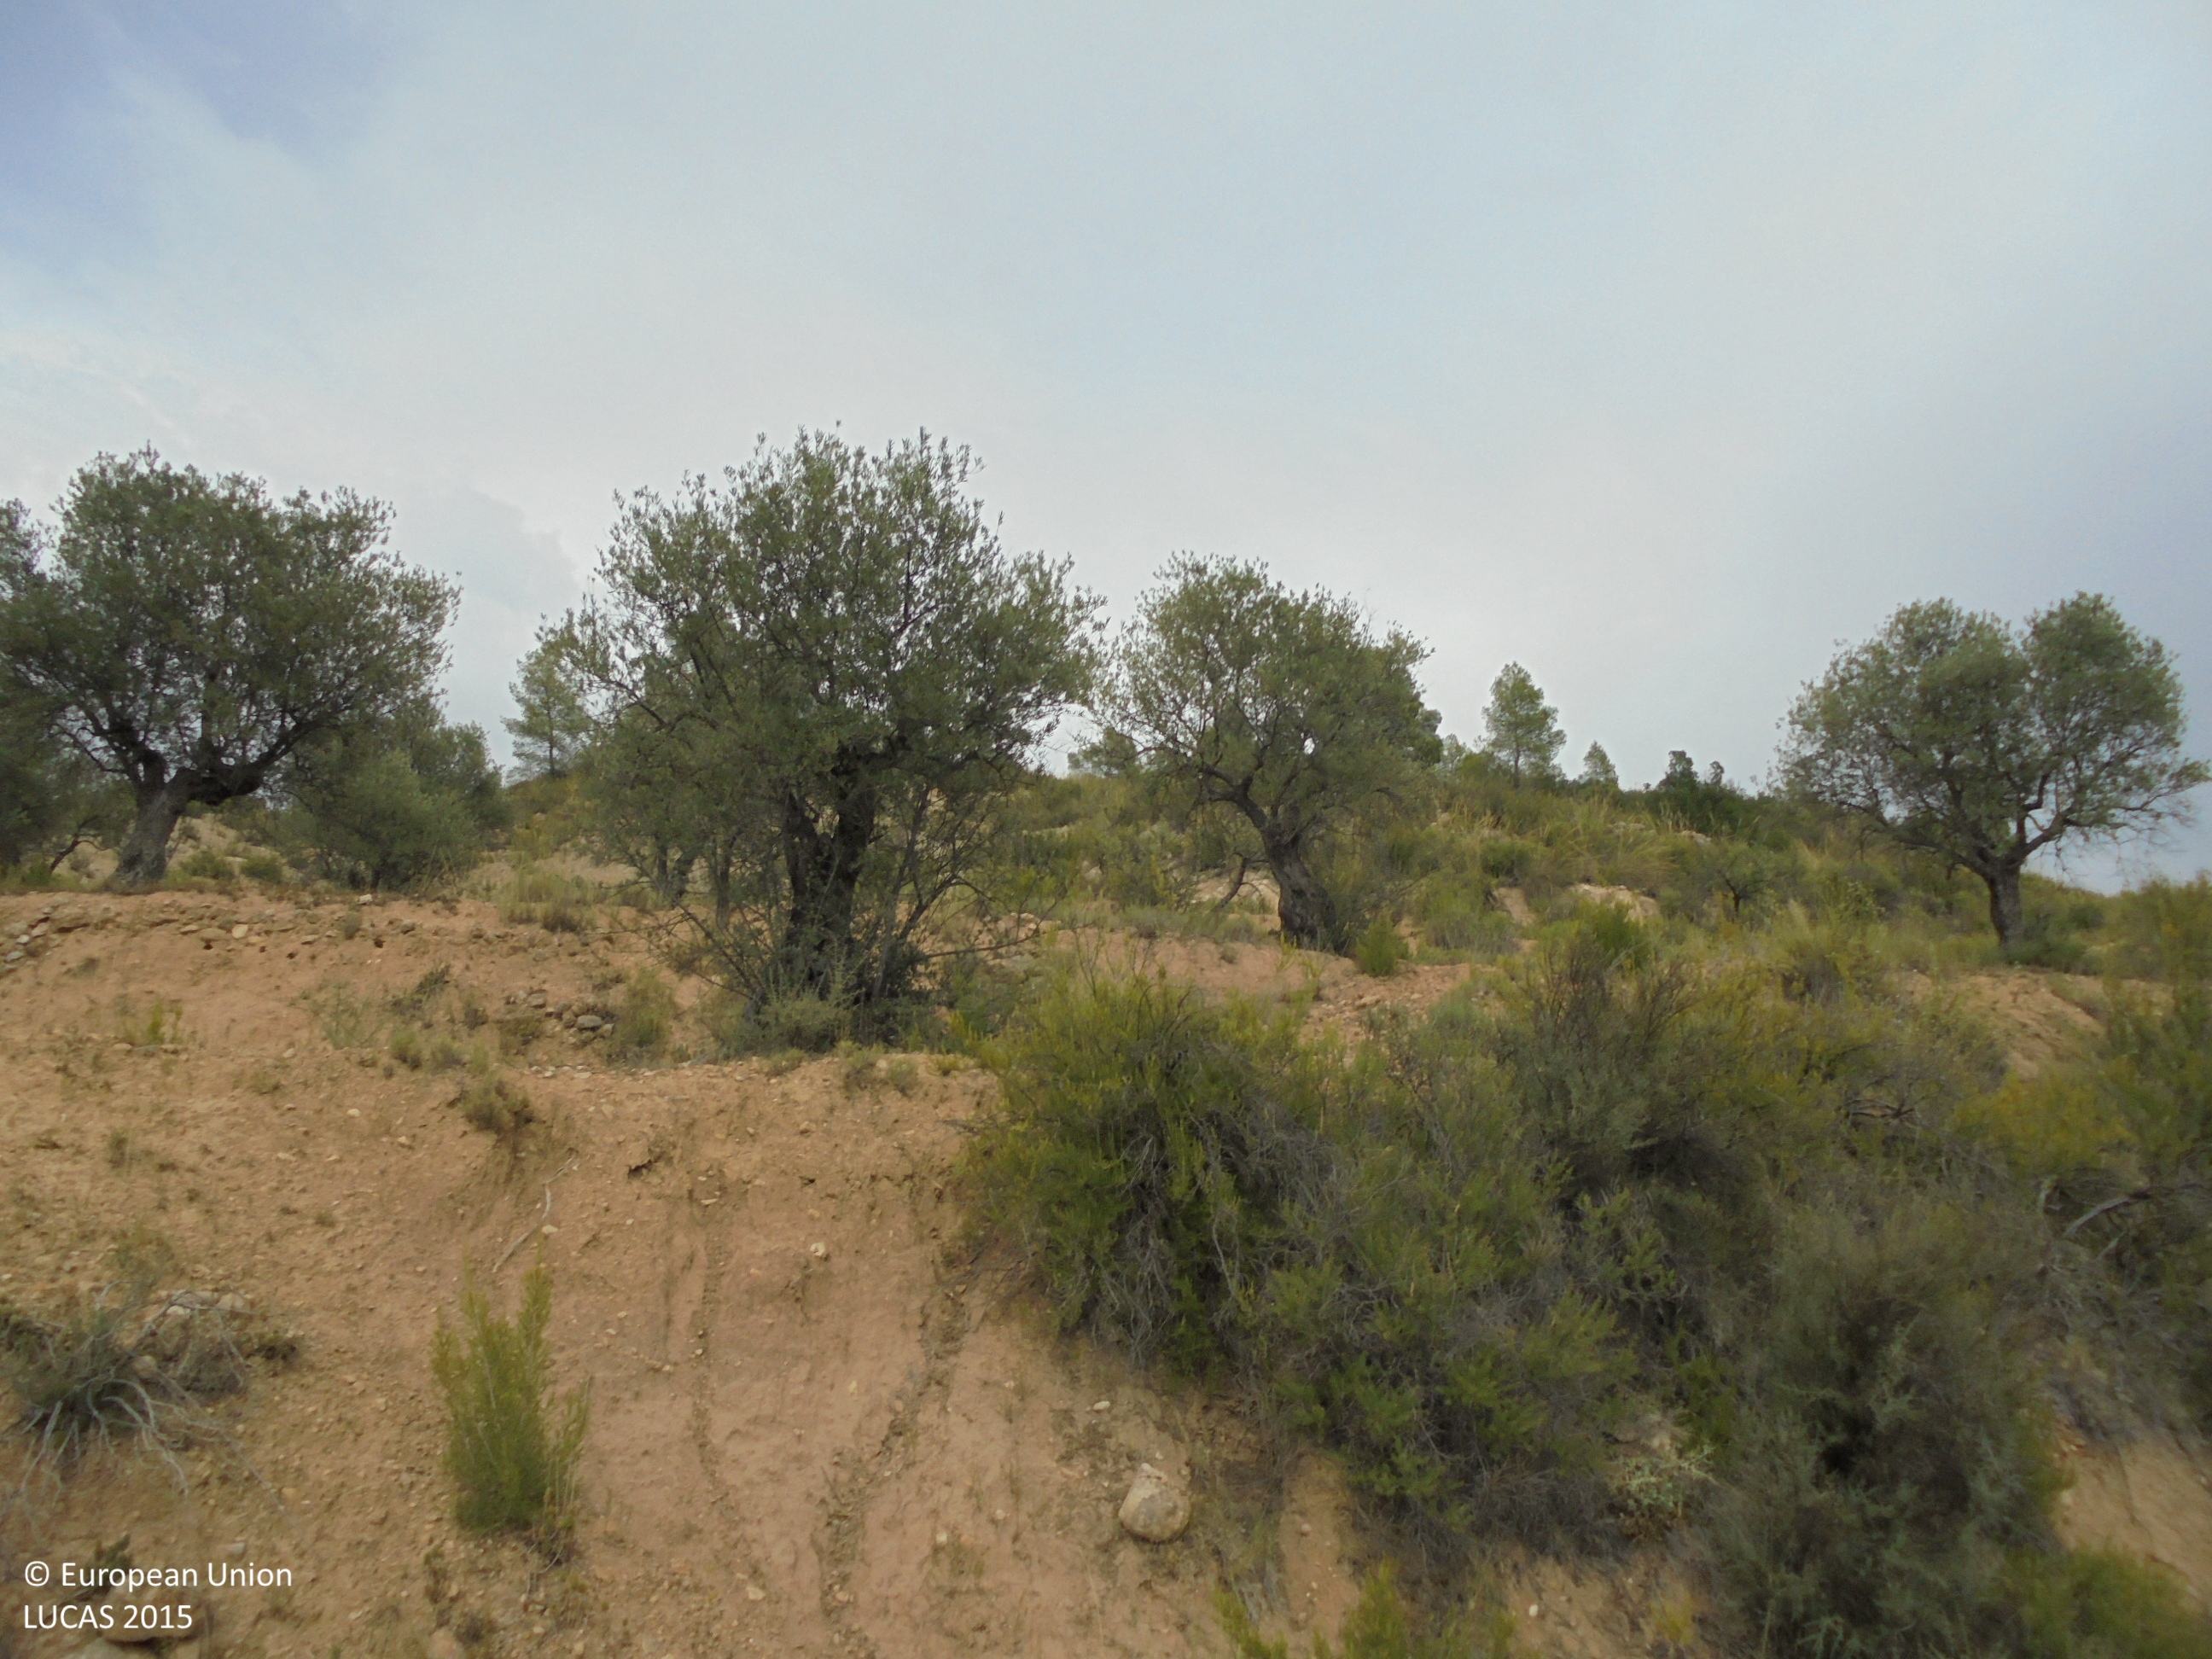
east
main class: Cropland
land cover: Olive groves
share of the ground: 25 - 50 %
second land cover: Shrubland without tree cover
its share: 25 - 50 %
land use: Abandoned areas
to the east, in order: Olive groves; Shrubland without tree cover; Dry stone walls; Olive groves; Shrubland without tree cover; Shrubland with sparse tree cover; Pine dominated coniferous woodland; Shrubland without tree cover; Shrubland with sparse tree cover
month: August
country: ES
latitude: 39.1486
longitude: -1.0474
